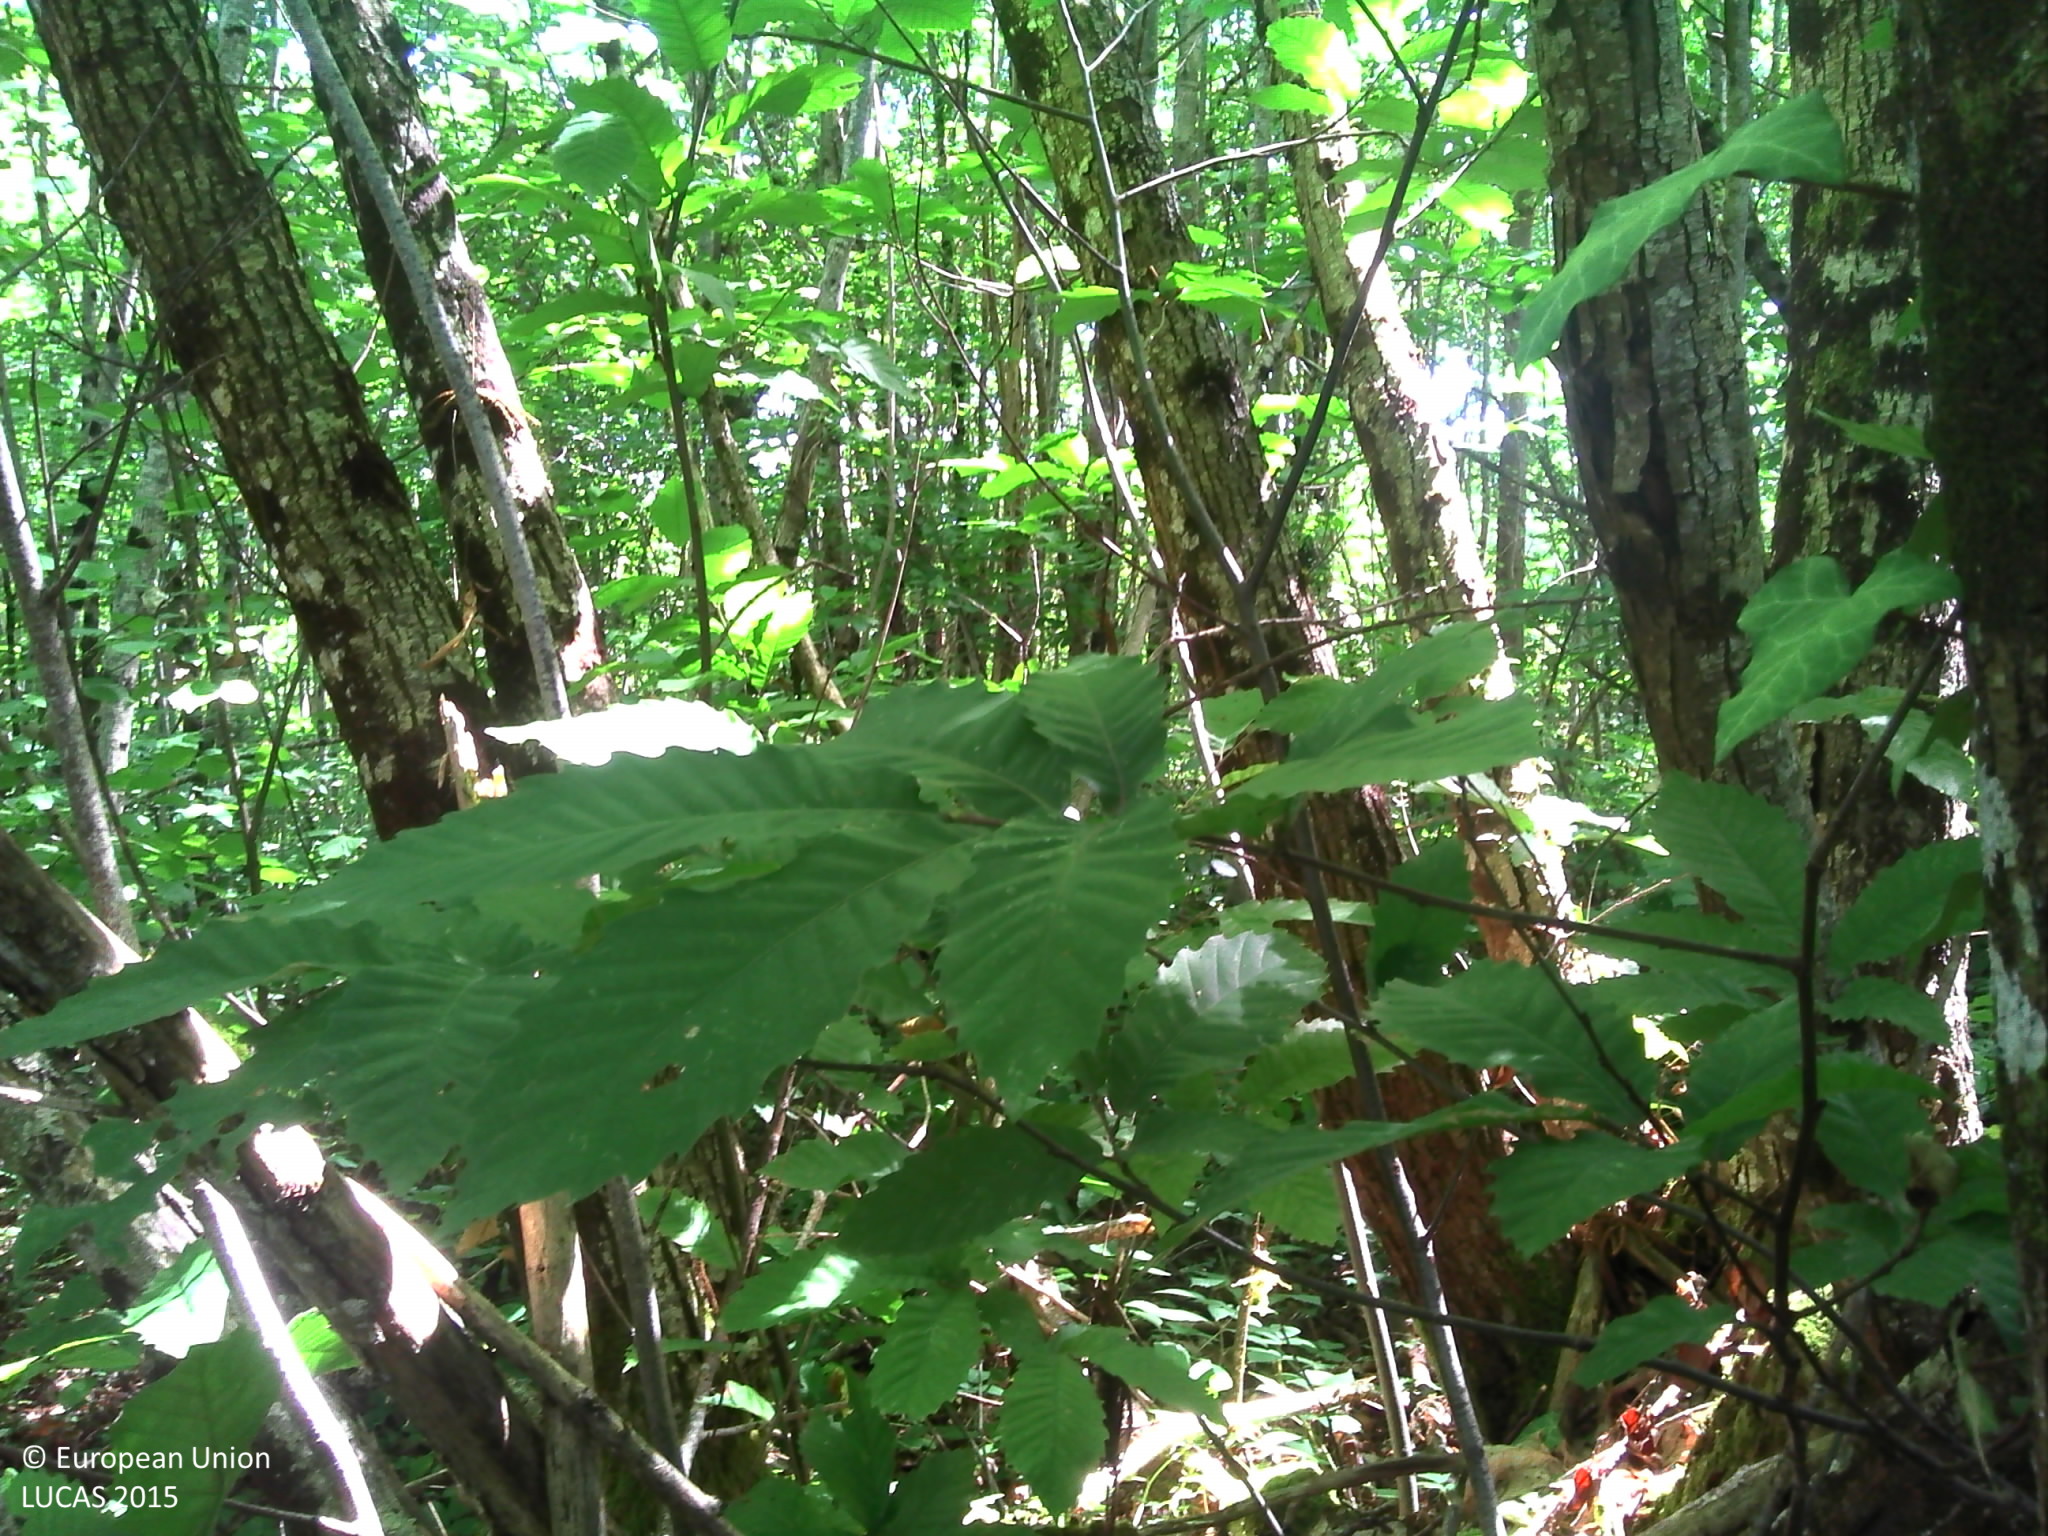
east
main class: Woodland
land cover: Broadleaved woodland
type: mesophytic deciduous forest
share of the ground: > 75 %
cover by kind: broadleaved forest trees 70 %, shrubs 10 %, herbaceous plants 10 %, consolidated bare surface 10 %
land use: Forestry
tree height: > 5 m
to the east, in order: Broadleaved woodland; Fences; Grassland without tree/shrub cover; Broadleaved woodland; Fences; Broadleaved woodland; Grassland without tree/shrub cover
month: August
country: FR
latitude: 45.2229
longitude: 0.7315
